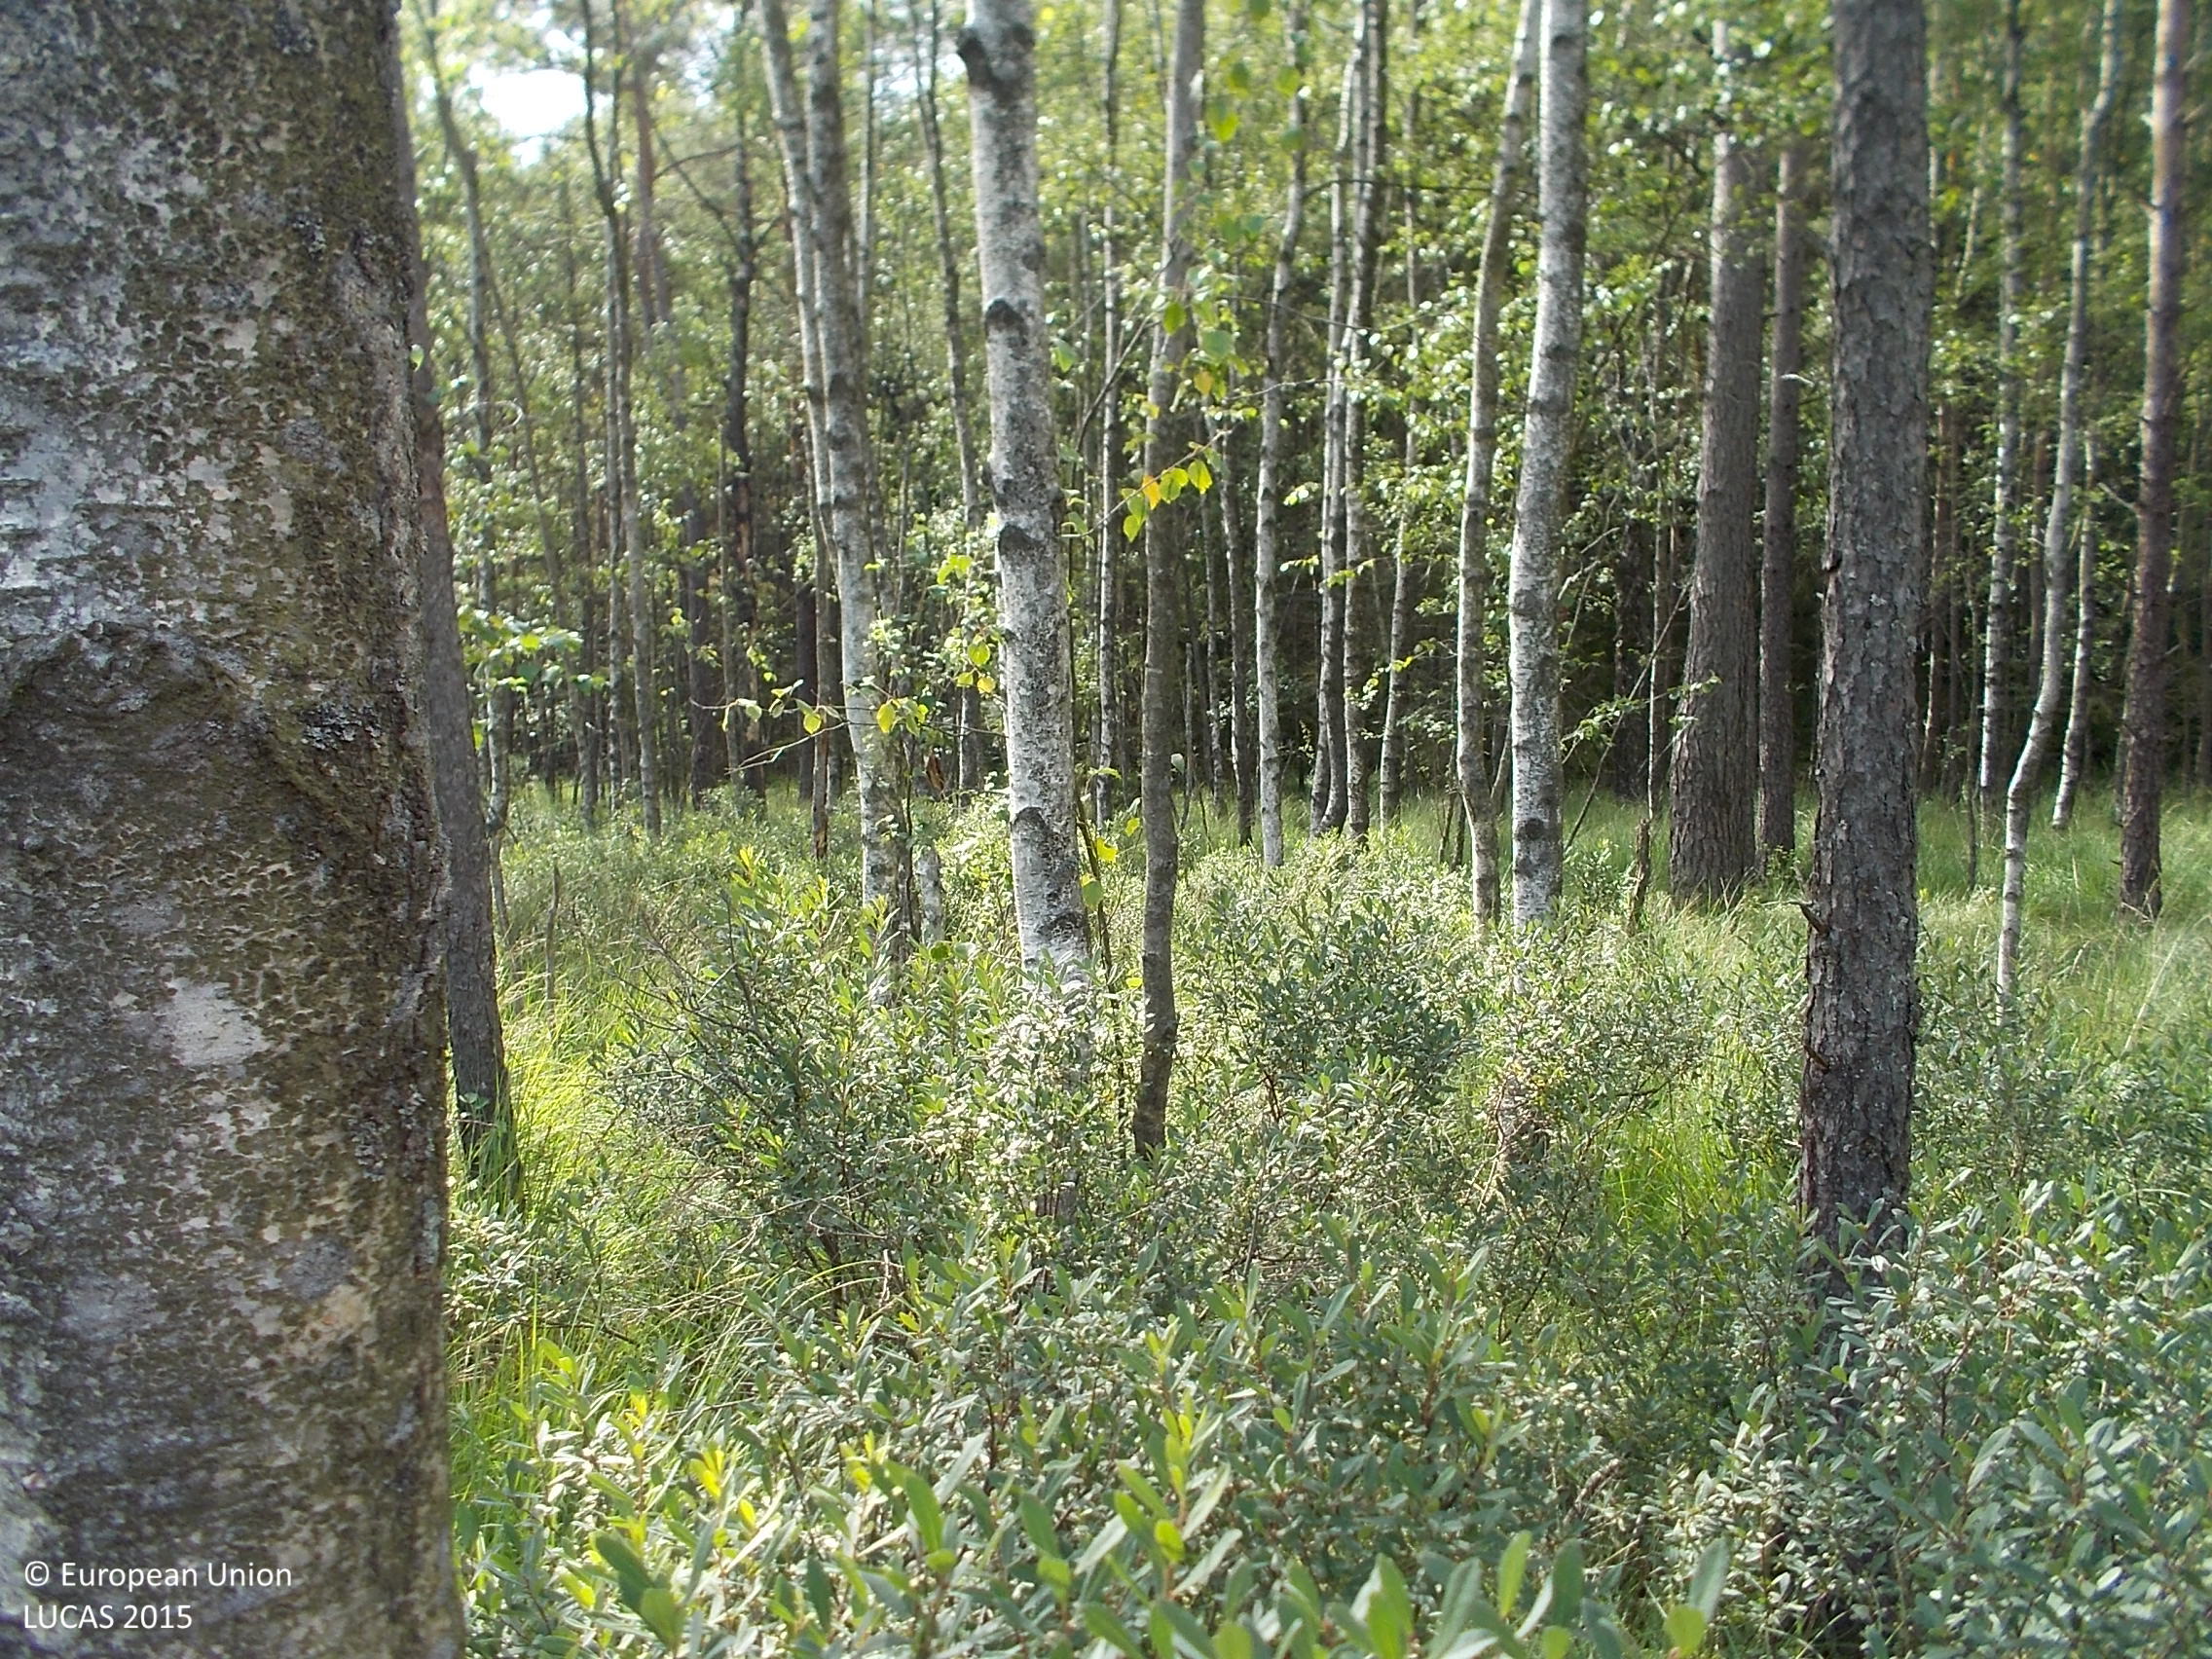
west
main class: Woodland
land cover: Pine dominated mixed woodland
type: mire and swamp forests
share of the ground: 25 - 50 %
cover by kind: herbaceous plants 30 %, coniferous forest trees 25 %, broadleaved forest trees 25 %, shrubs 20 %
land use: Semi-natural and natural areas not in use
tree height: > 5 m
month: August
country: SE
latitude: 57.5361
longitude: 12.1847
